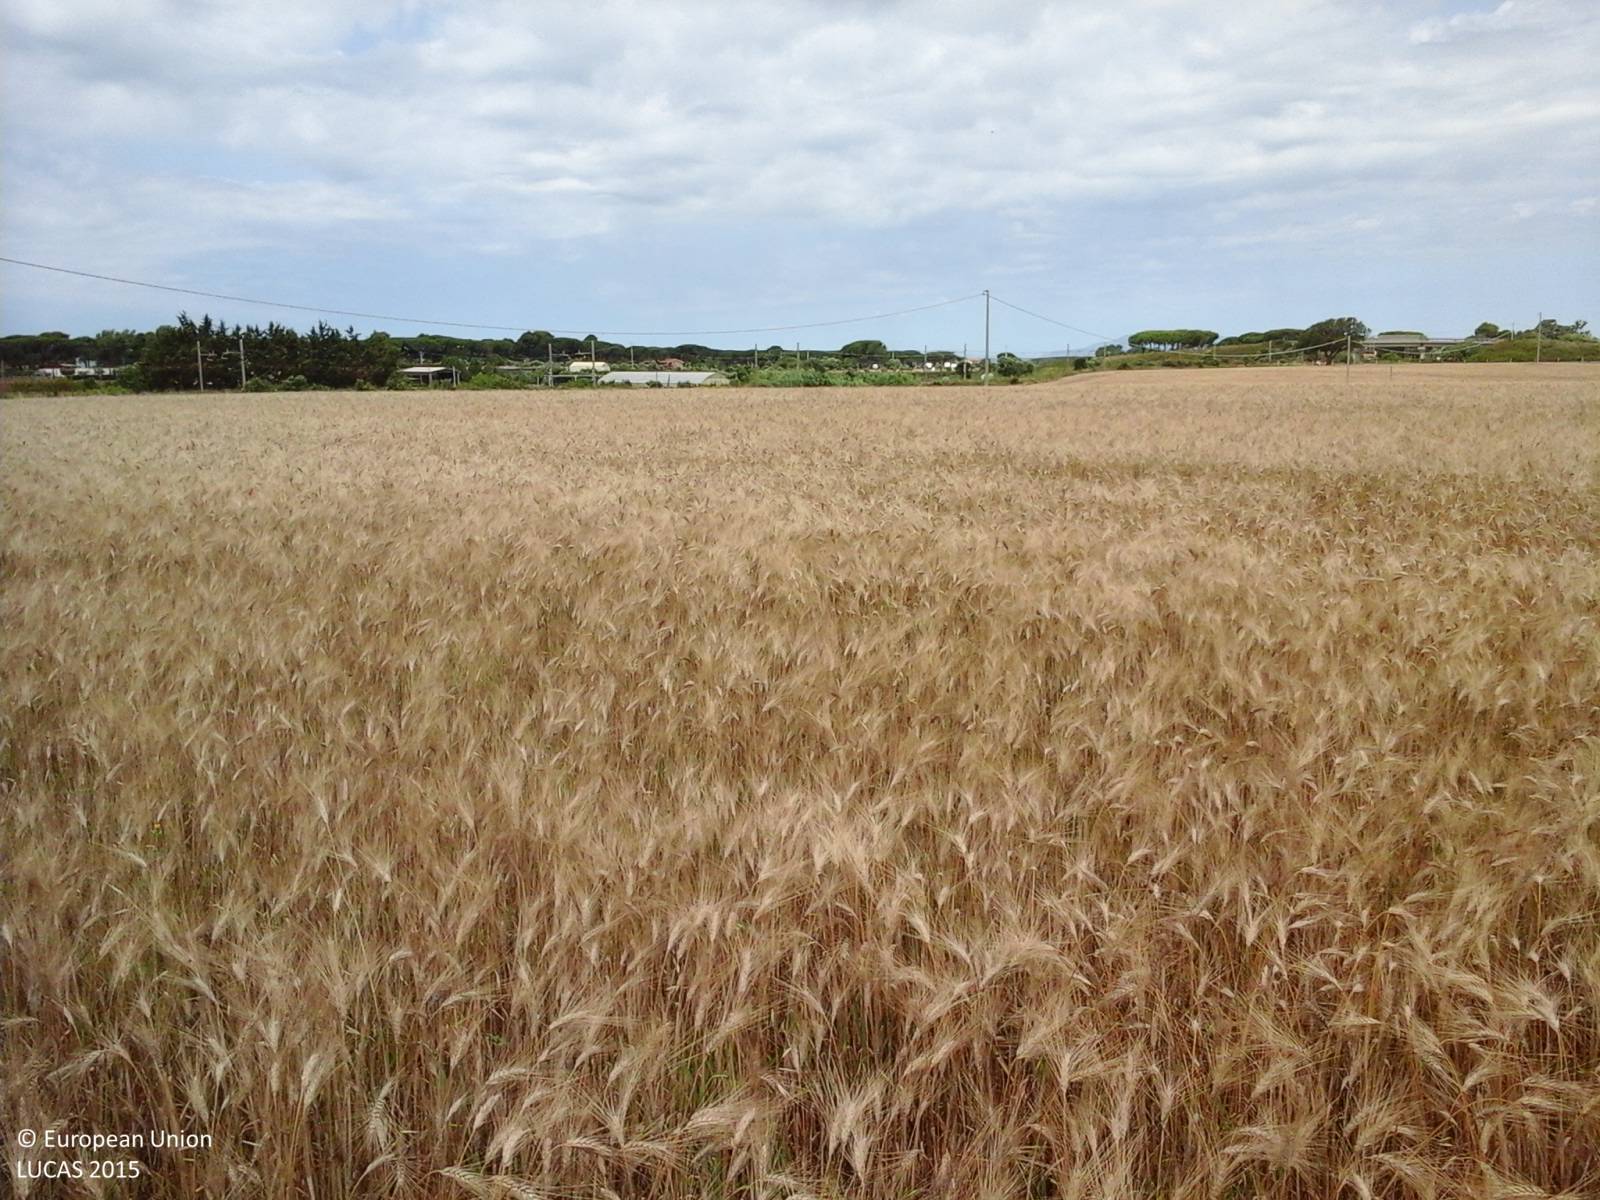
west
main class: Cropland
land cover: Durum wheat
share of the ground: > 75 %
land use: Agriculture (excluding fallow land and kitchen gardens)
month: June
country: IT
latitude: 42.2972
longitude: 11.6558
